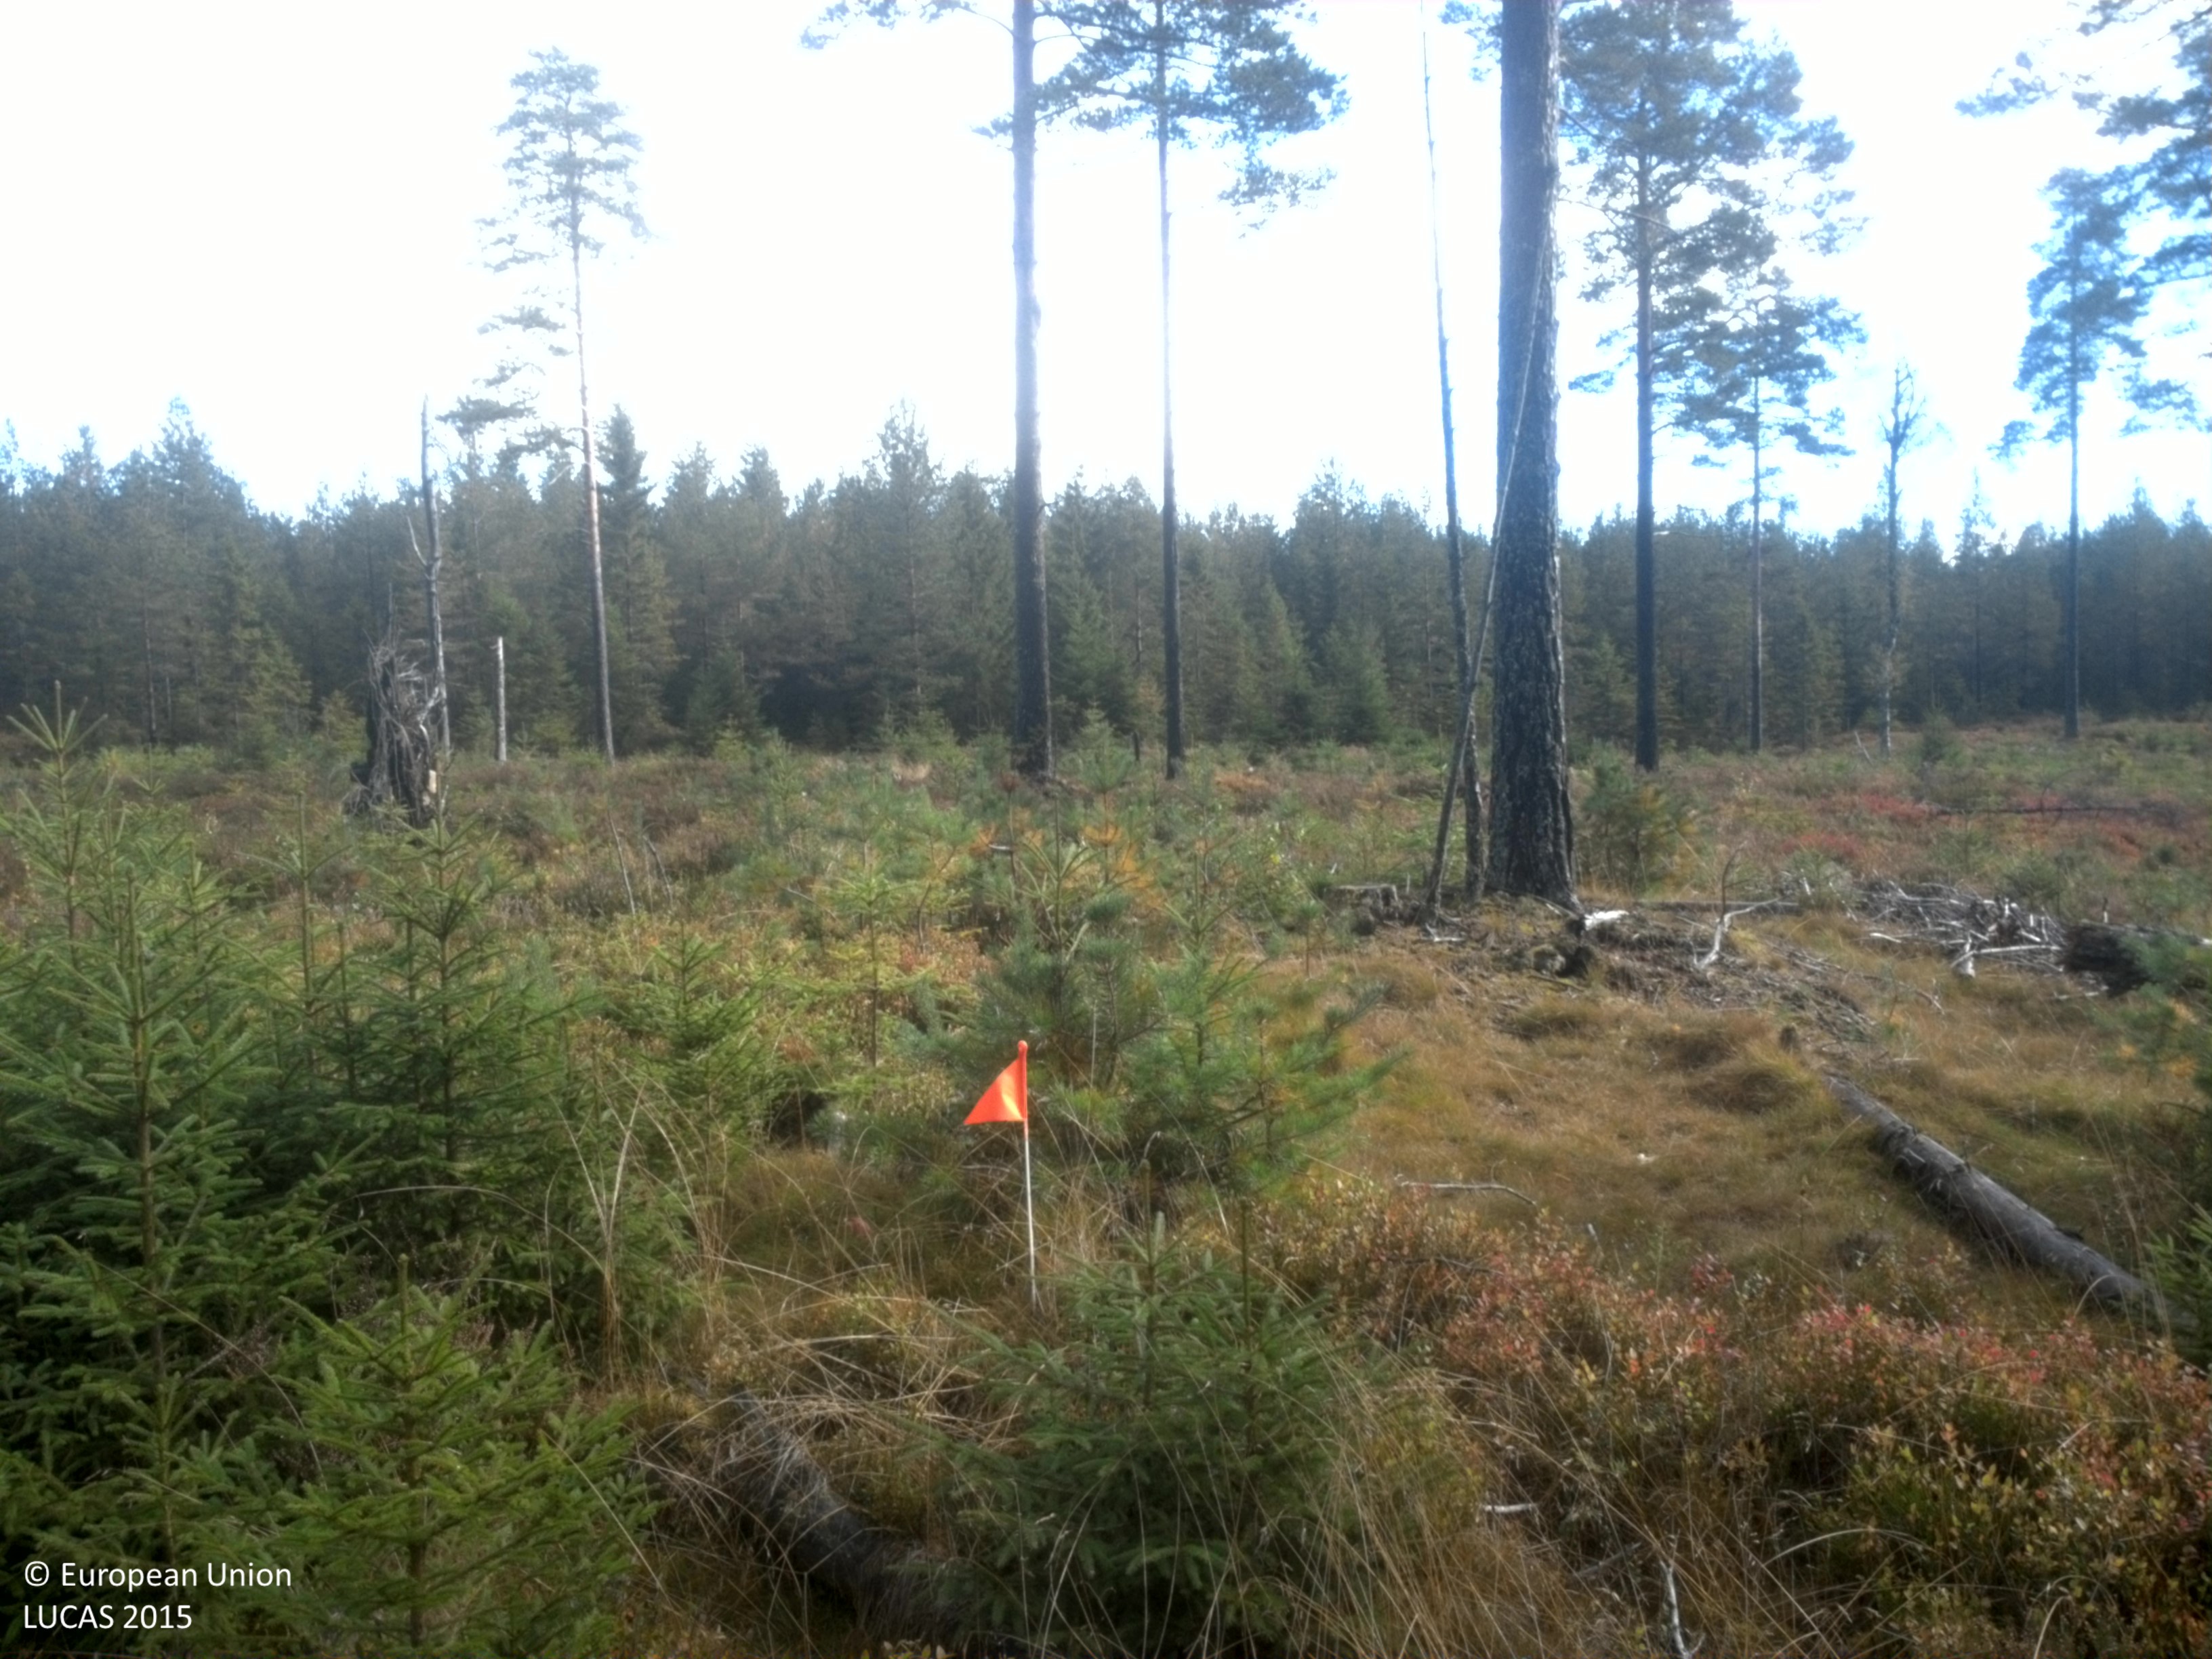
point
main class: Woodland
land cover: Other coniferous woodland
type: boreal forest
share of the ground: 50 - 75 %
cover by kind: coniferous forest trees 60 %, shrubs 30 %, herbaceous plants 10 %
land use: Forestry
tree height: > 5 m
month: September
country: SE
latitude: 59.8566
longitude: 15.5065
